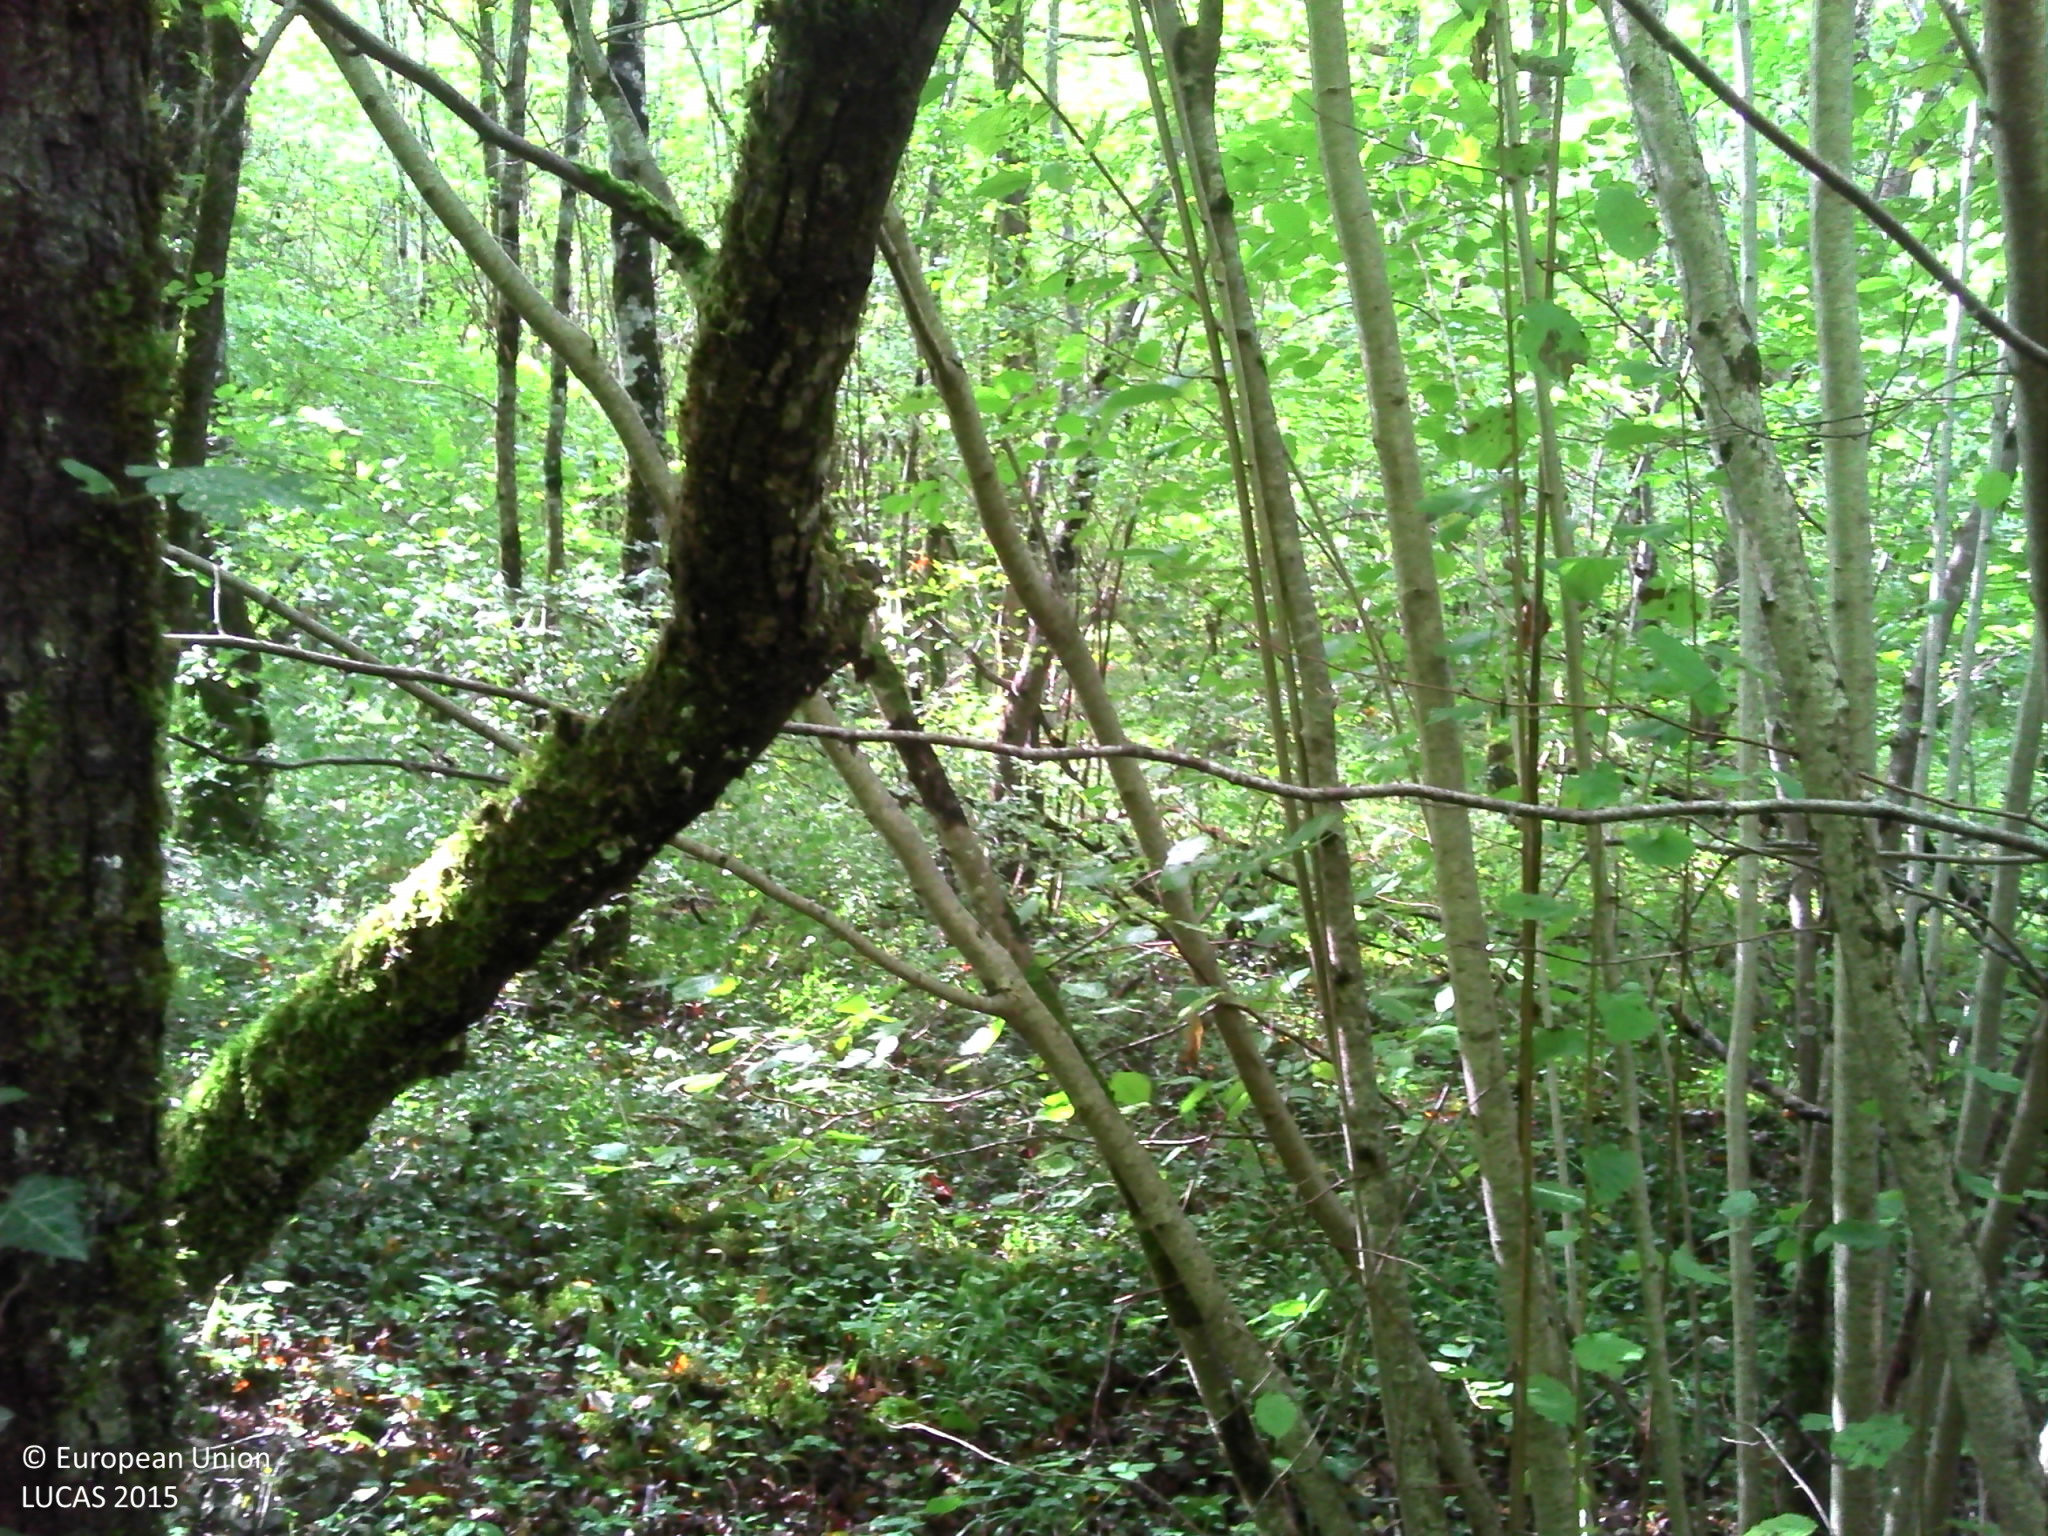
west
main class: Woodland
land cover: Broadleaved woodland
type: mesophytic deciduous forest
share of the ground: > 75 %
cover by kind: broadleaved forest trees 90 %, herbaceous plants 5 %, lichens and mosses 5 %
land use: Forestry
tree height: > 5 m
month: September
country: FR
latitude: 47.6784
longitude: 4.2838
